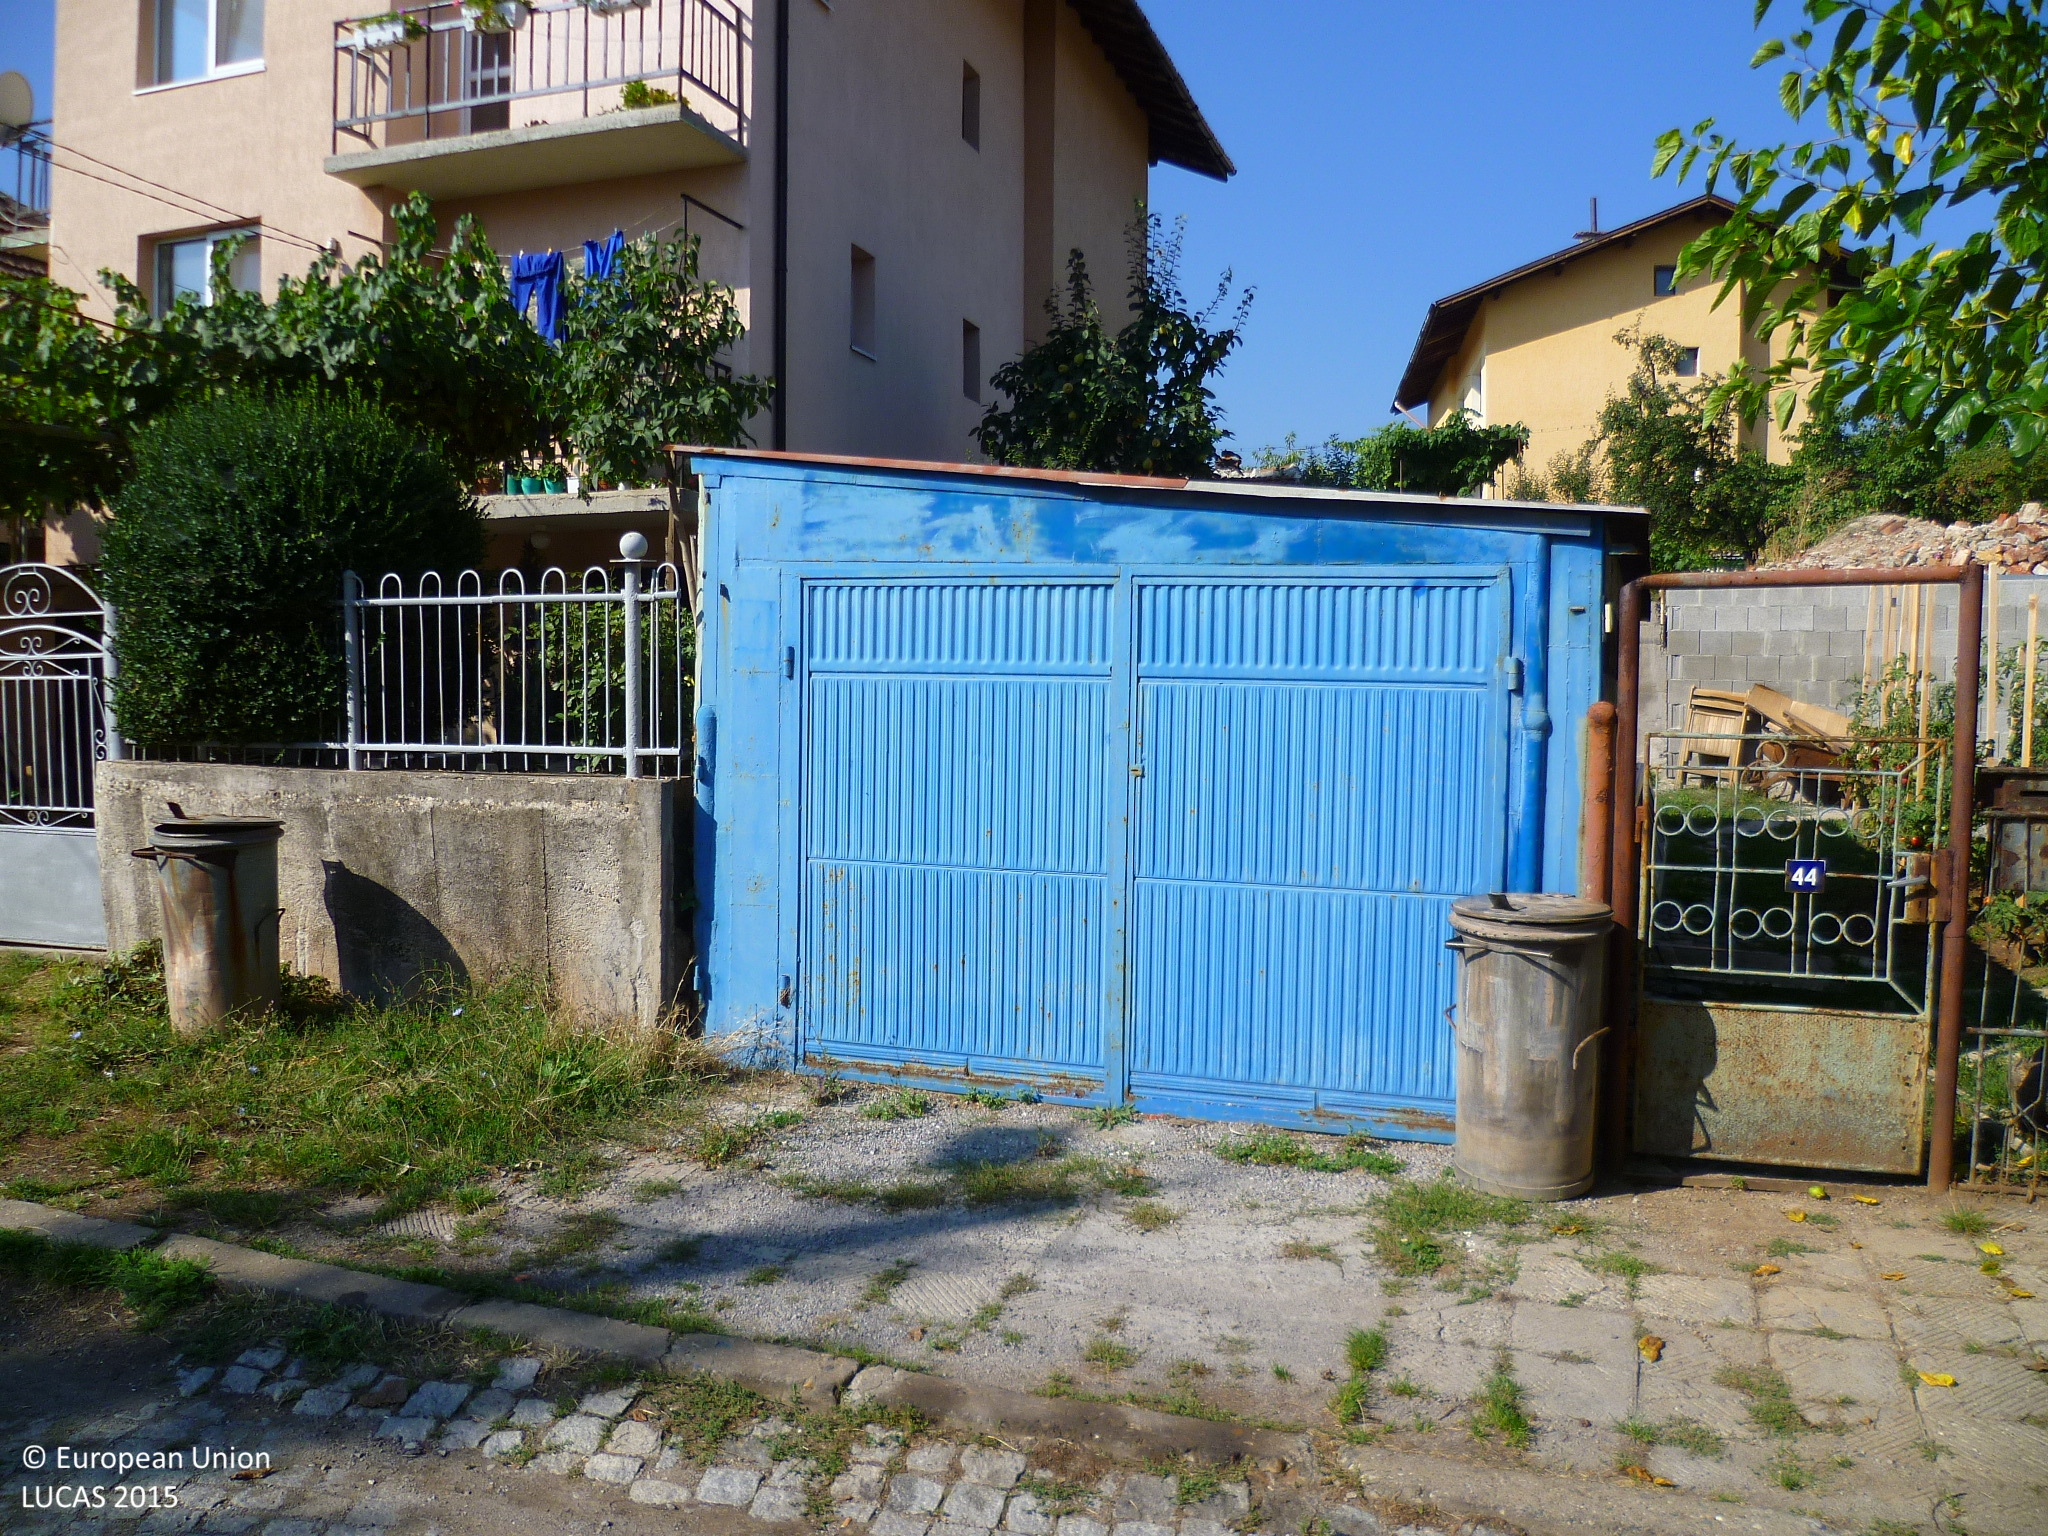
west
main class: Woodland
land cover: Broadleaved woodland
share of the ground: > 75 %
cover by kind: broadleaved forest trees 100 %
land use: Residential
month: September
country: BG
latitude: 42.5936
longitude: 23.0324
